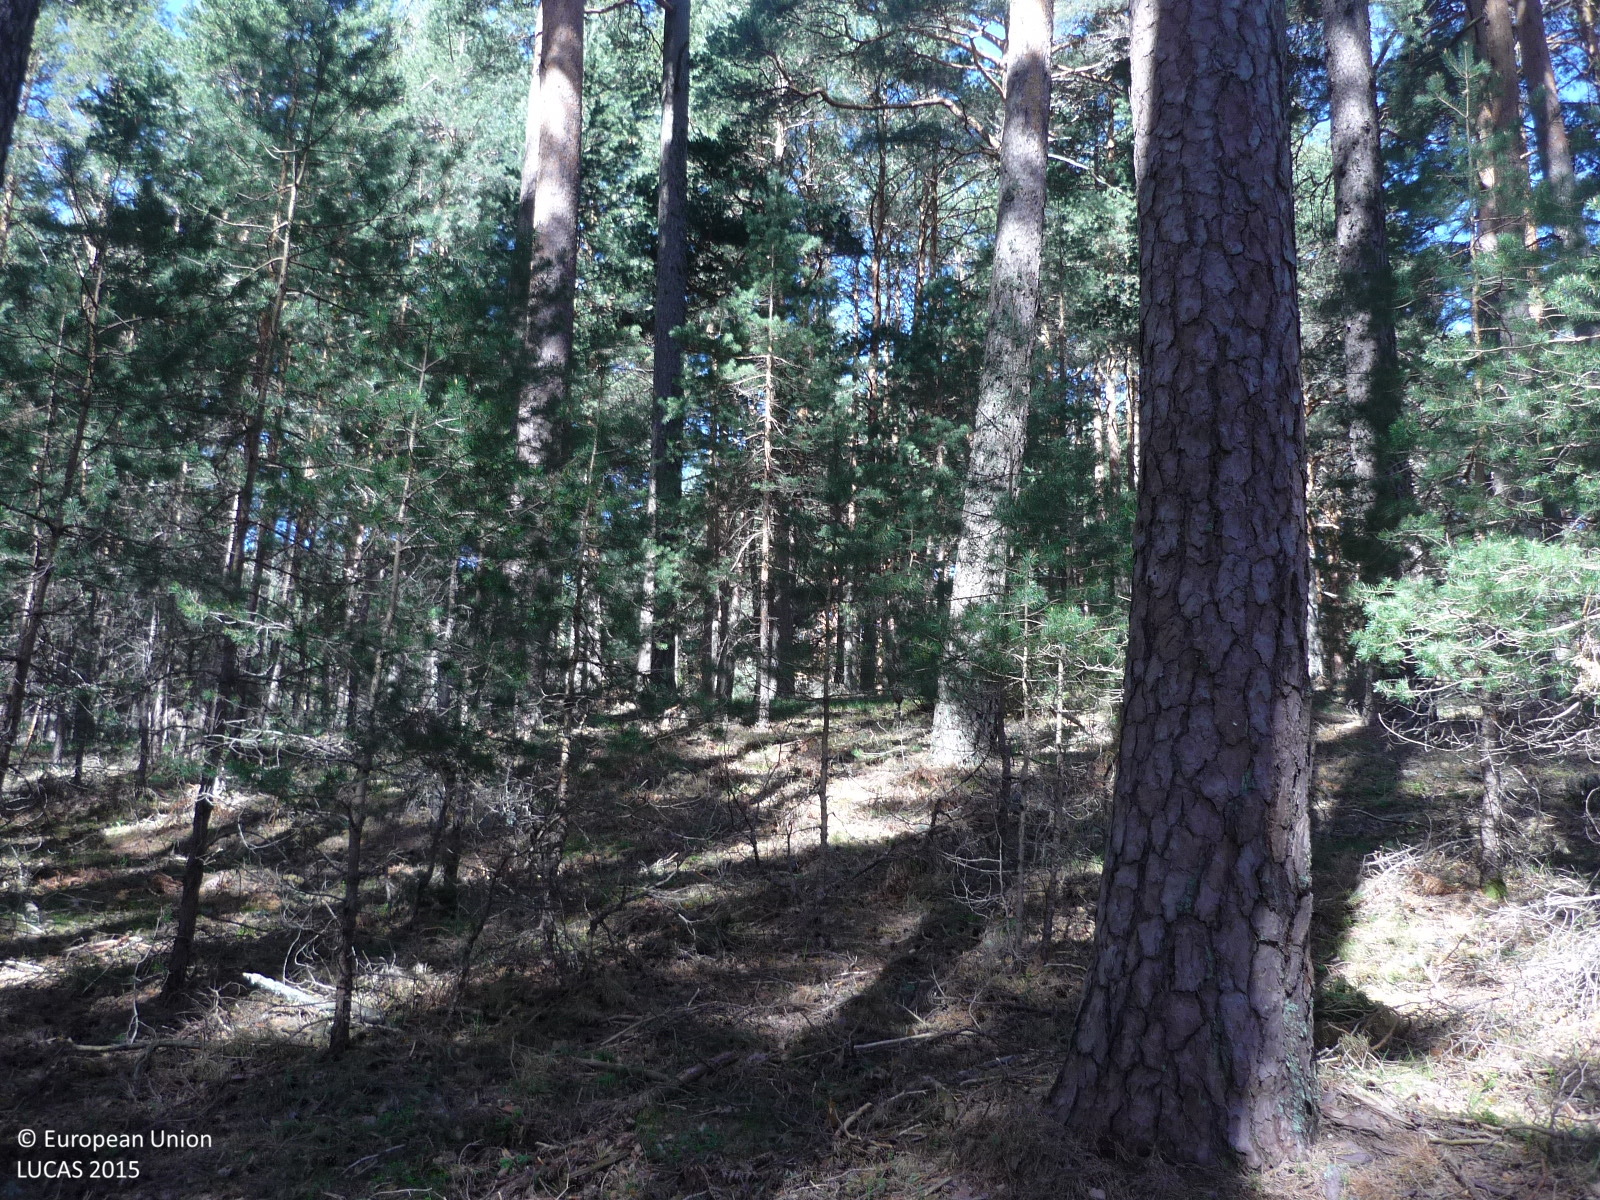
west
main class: Woodland
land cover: Pine dominated coniferous woodland
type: coniferous forest of the mediterranean region
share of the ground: > 75 %
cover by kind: coniferous forest trees 90 %, herbaceous plants 10 %
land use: Forestry
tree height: > 5 m
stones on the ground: < 10 %
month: May
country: ES
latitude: 40.8300
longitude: -4.0281
